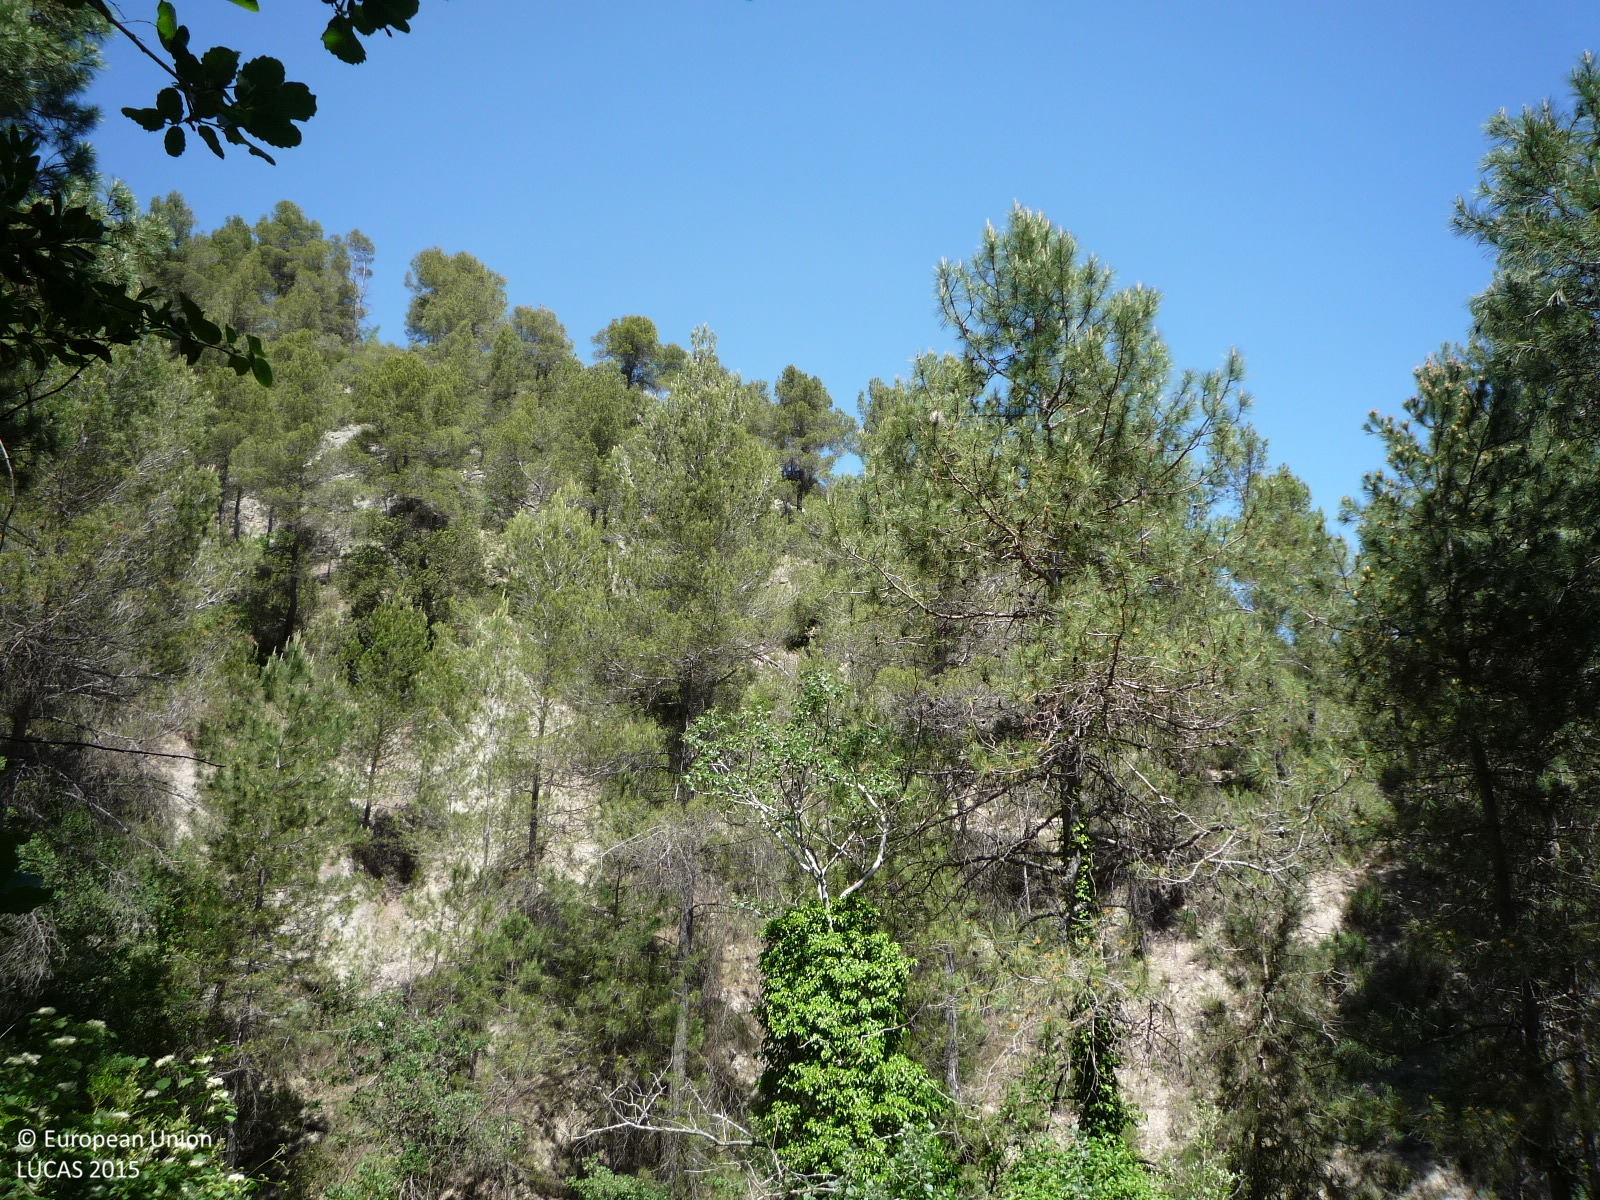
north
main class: Woodland
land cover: Pine dominated mixed woodland
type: coniferous forest of the mediterranean region
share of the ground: > 75 %
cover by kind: coniferous forest trees 70 %, broadleaved forest trees 25 %, shrubs 5 %
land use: Semi-natural and natural areas not in use
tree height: > 5 m
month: May
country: ES
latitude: 41.8264
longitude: 1.7428
